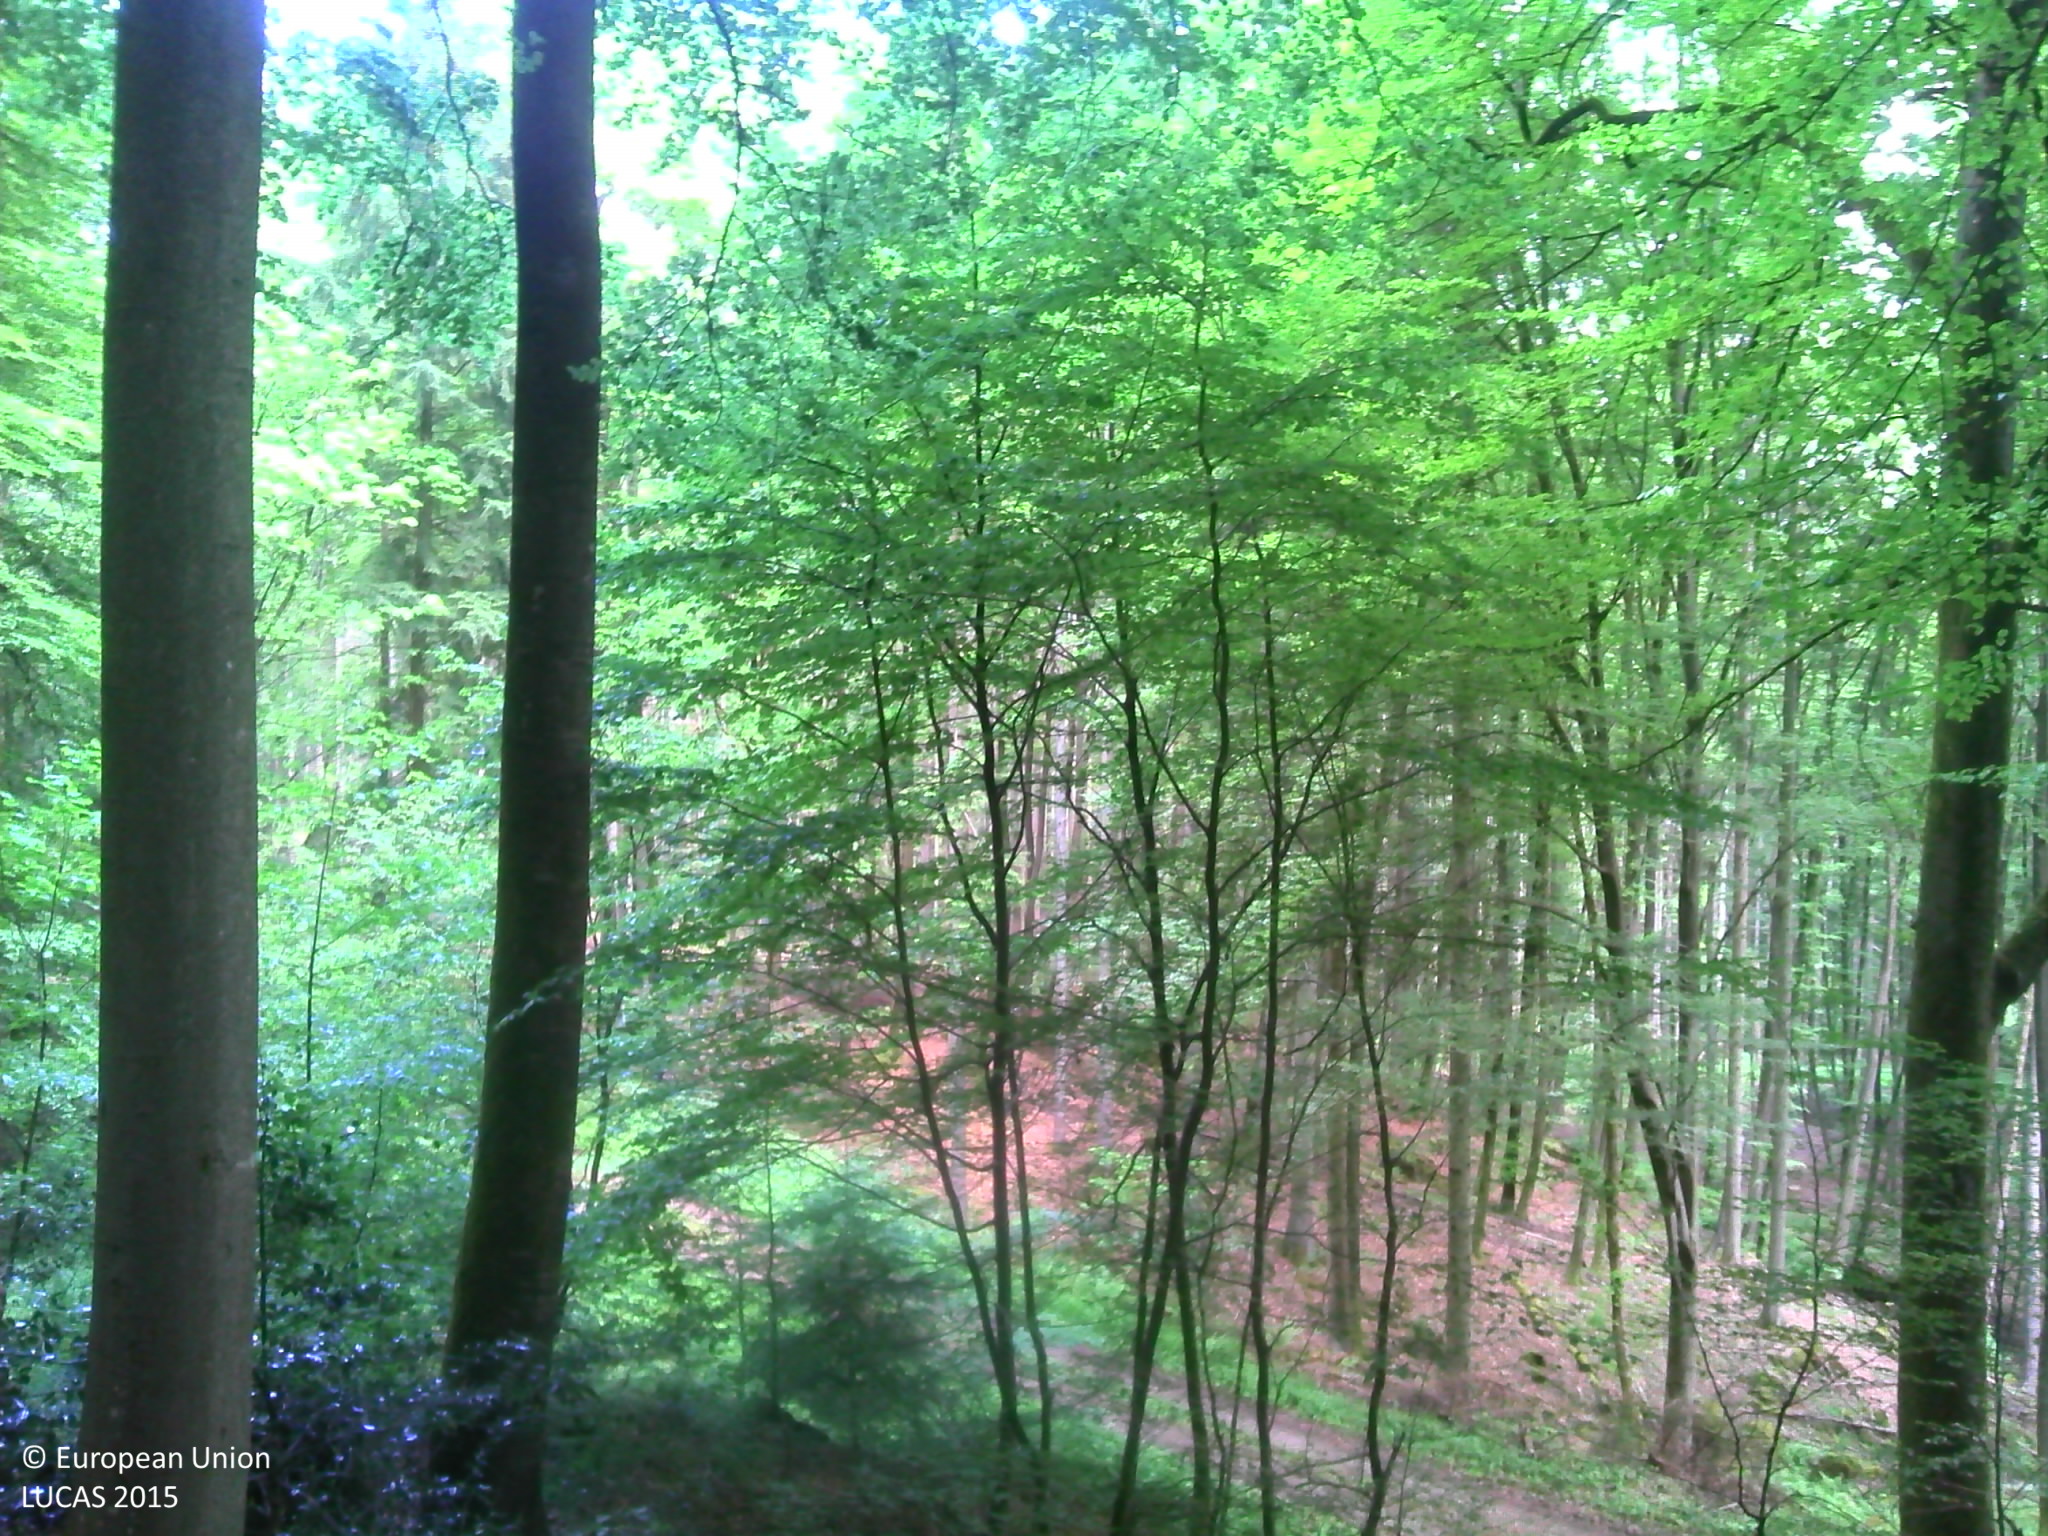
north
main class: Woodland
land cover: Broadleaved woodland
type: acidophilous oak and oak-birch forest
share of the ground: > 75 %
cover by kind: broadleaved forest trees 75 %, herbaceous plants 20 %, lichens and mosses 5 %
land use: Forestry
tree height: > 5 m
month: May
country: LU
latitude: 49.8385
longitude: 6.3706
